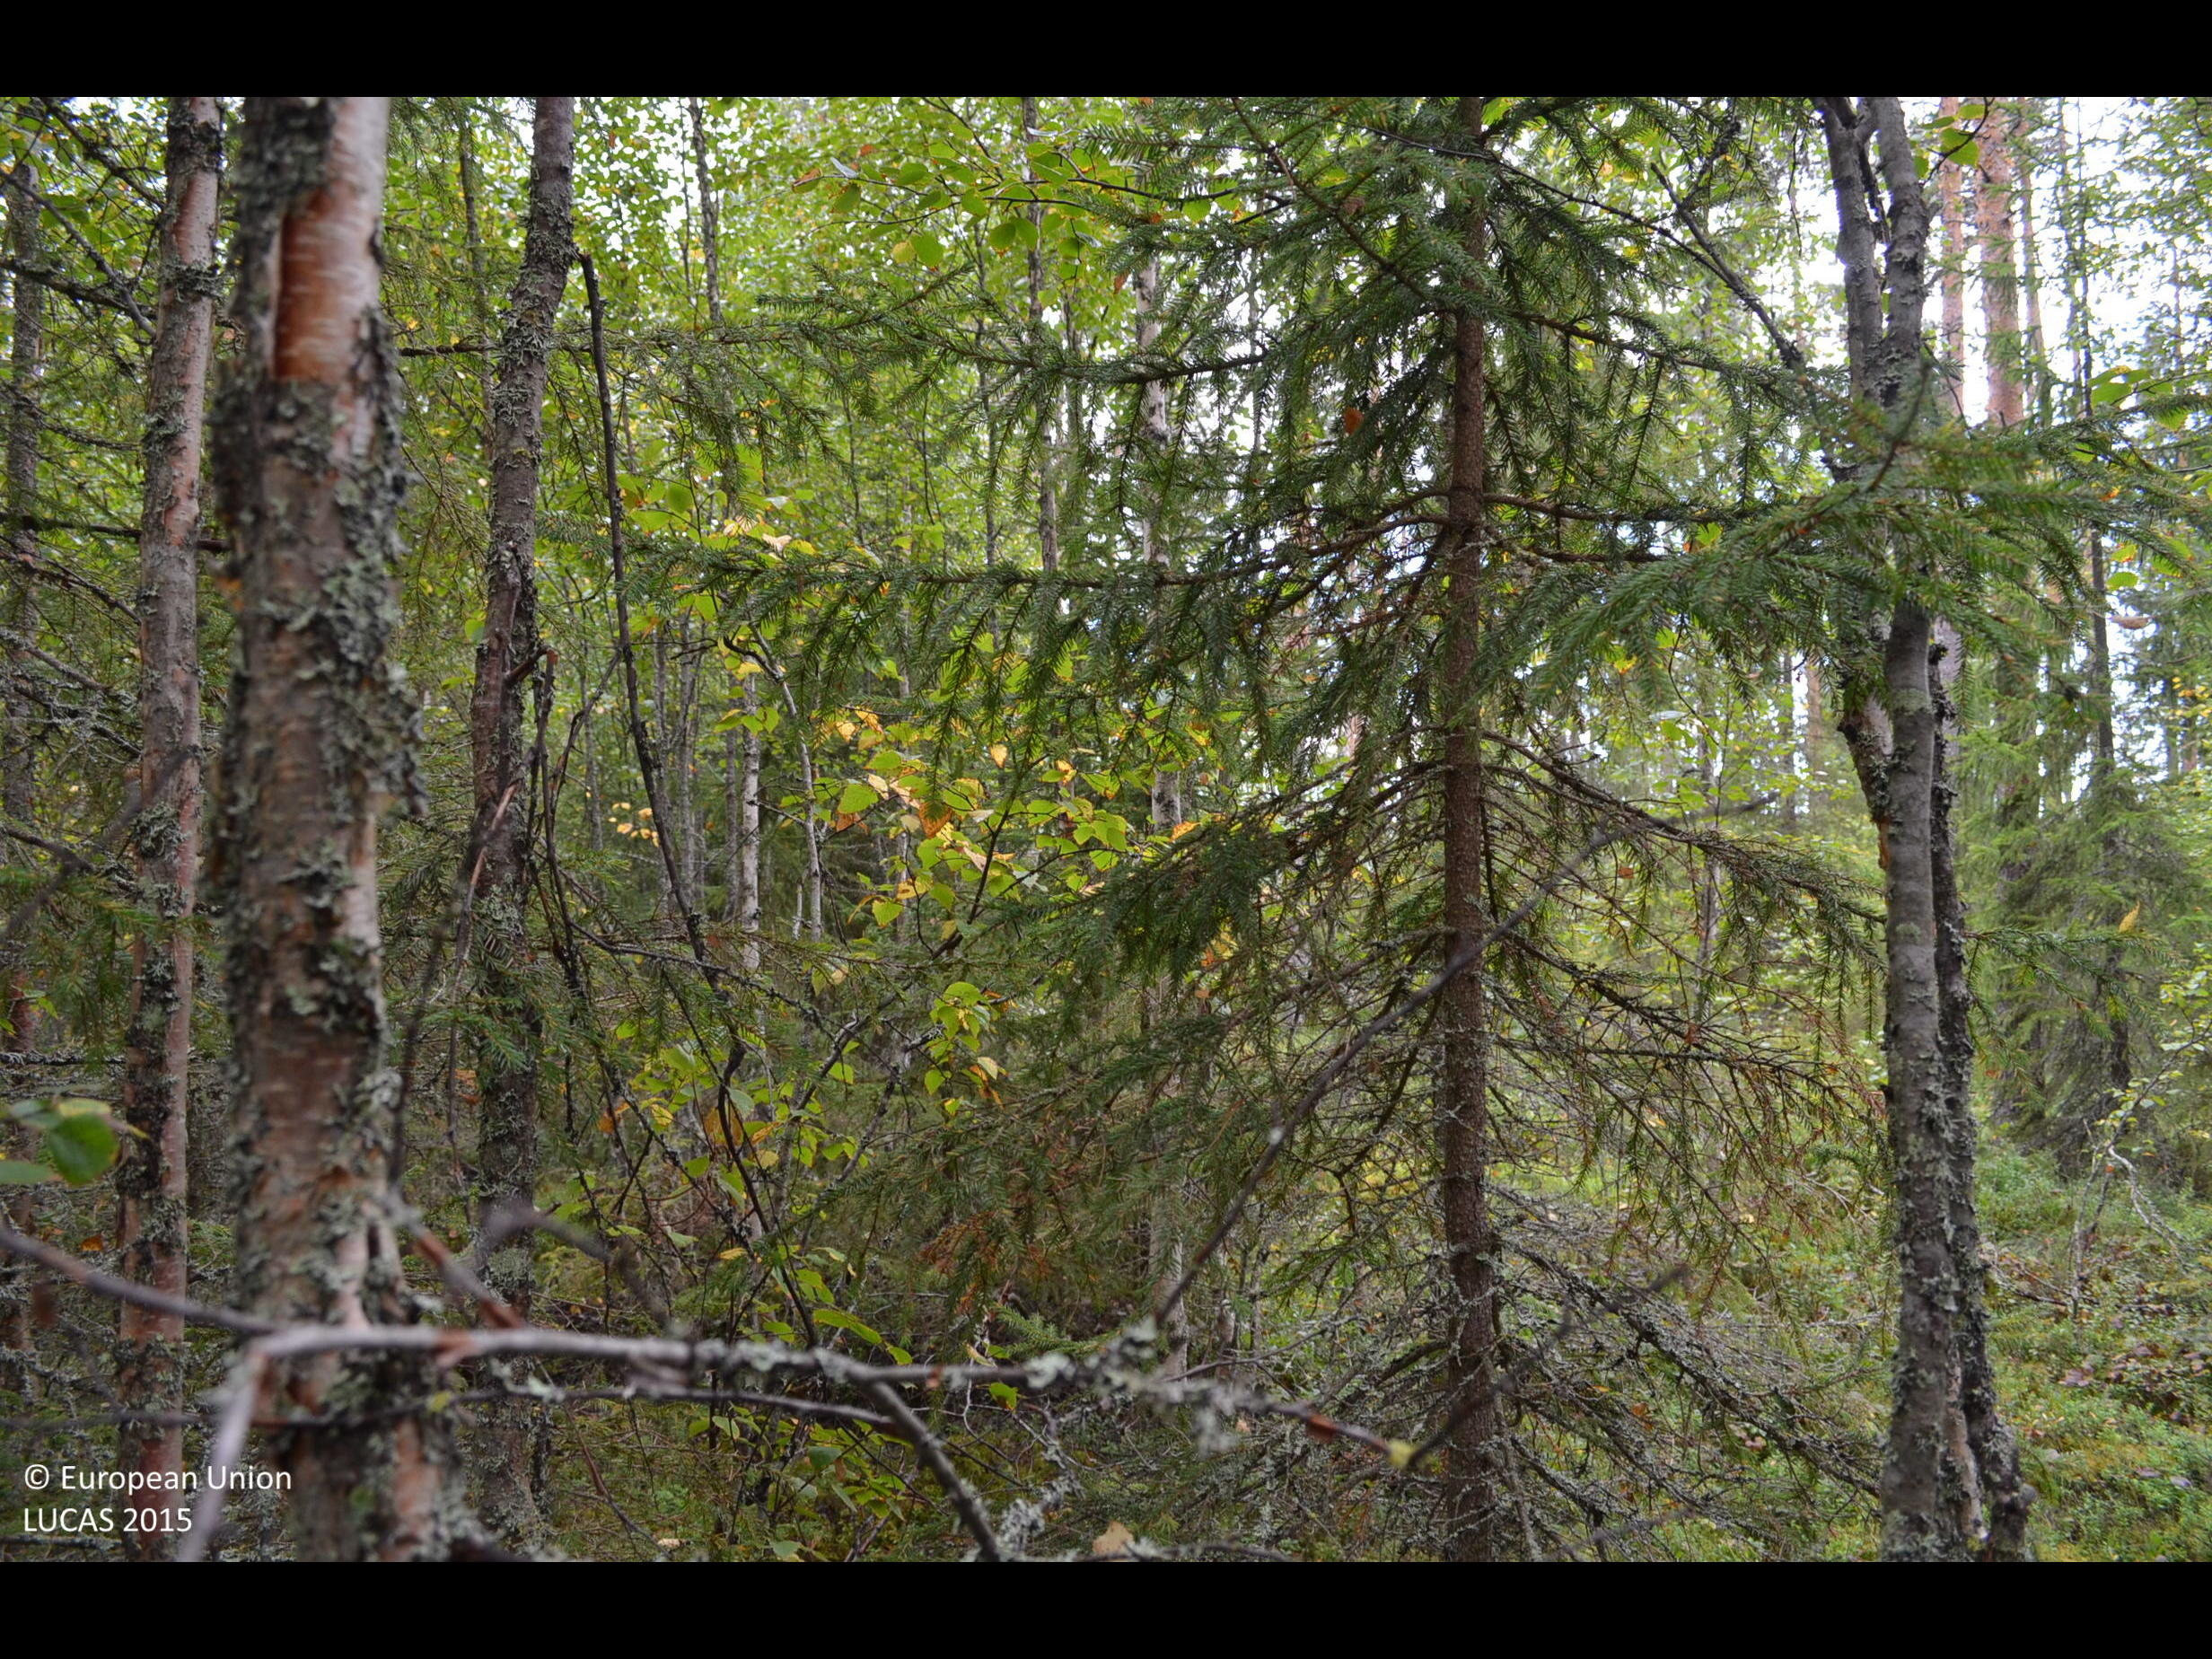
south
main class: Woodland
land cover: Other mixed woodland
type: boreal forest
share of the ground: > 75 %
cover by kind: broadleaved forest trees 40 %, coniferous forest trees 35 %, shrubs 20 %, lichens and mosses 5 %
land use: Forestry
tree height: > 5 m
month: August
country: FI
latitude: 62.6620
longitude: 24.4727
